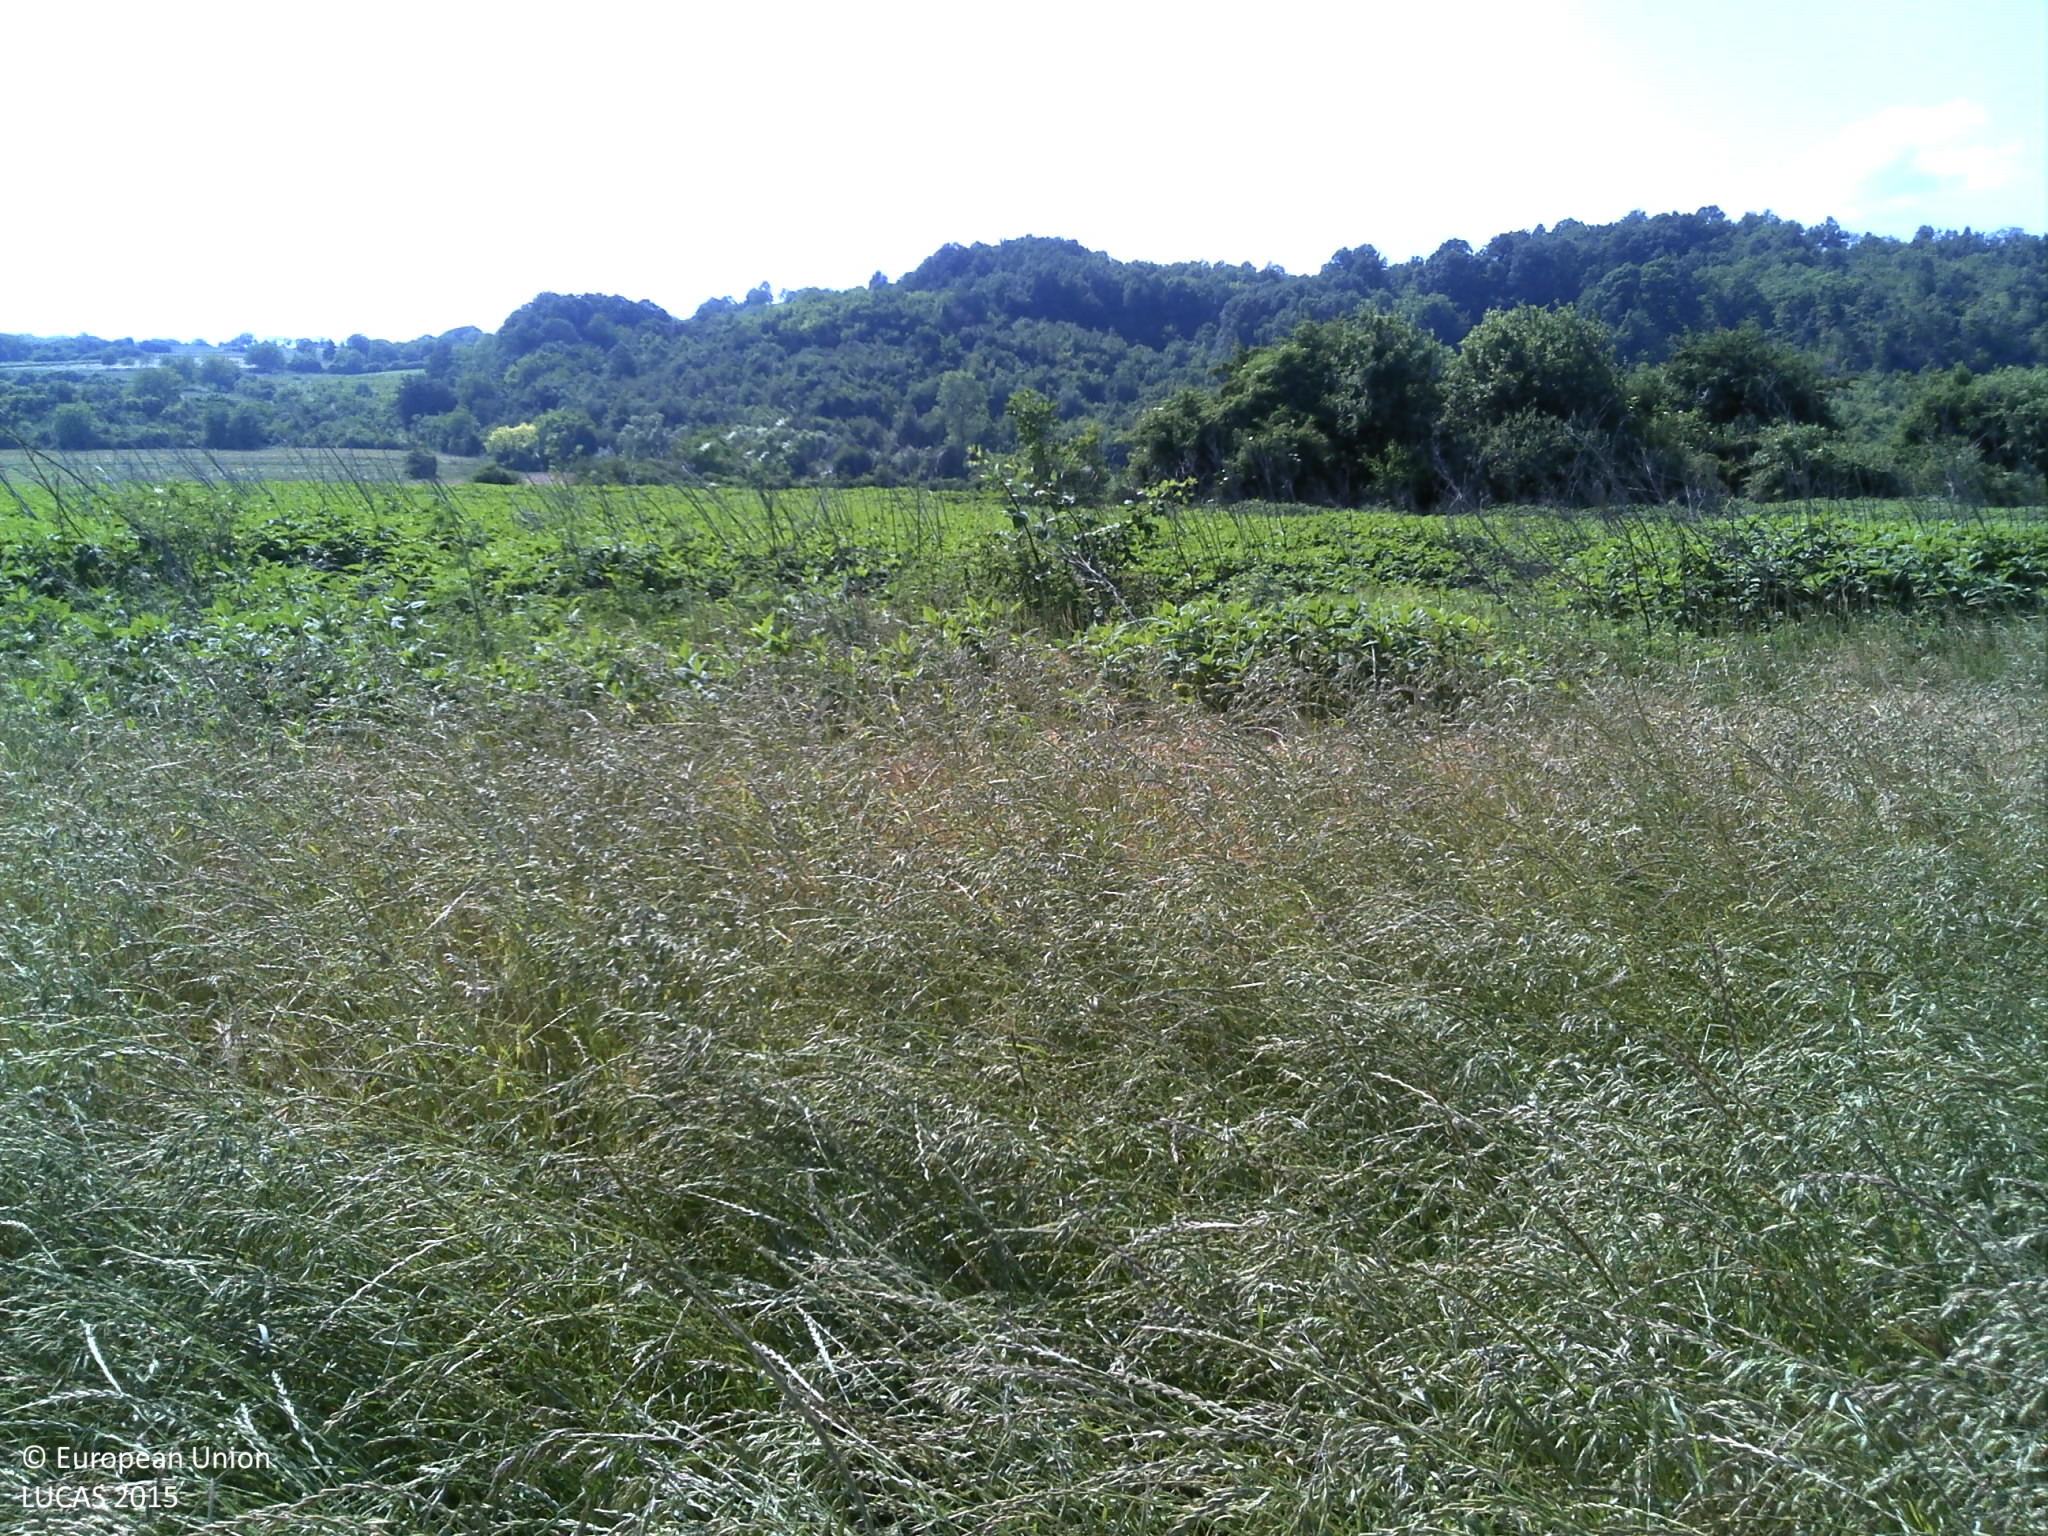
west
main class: Cropland
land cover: Mixed cereals for fodder
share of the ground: > 75 %
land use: Agriculture (excluding fallow land and kitchen gardens)
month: June
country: HR
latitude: 45.2375
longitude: 17.9897
